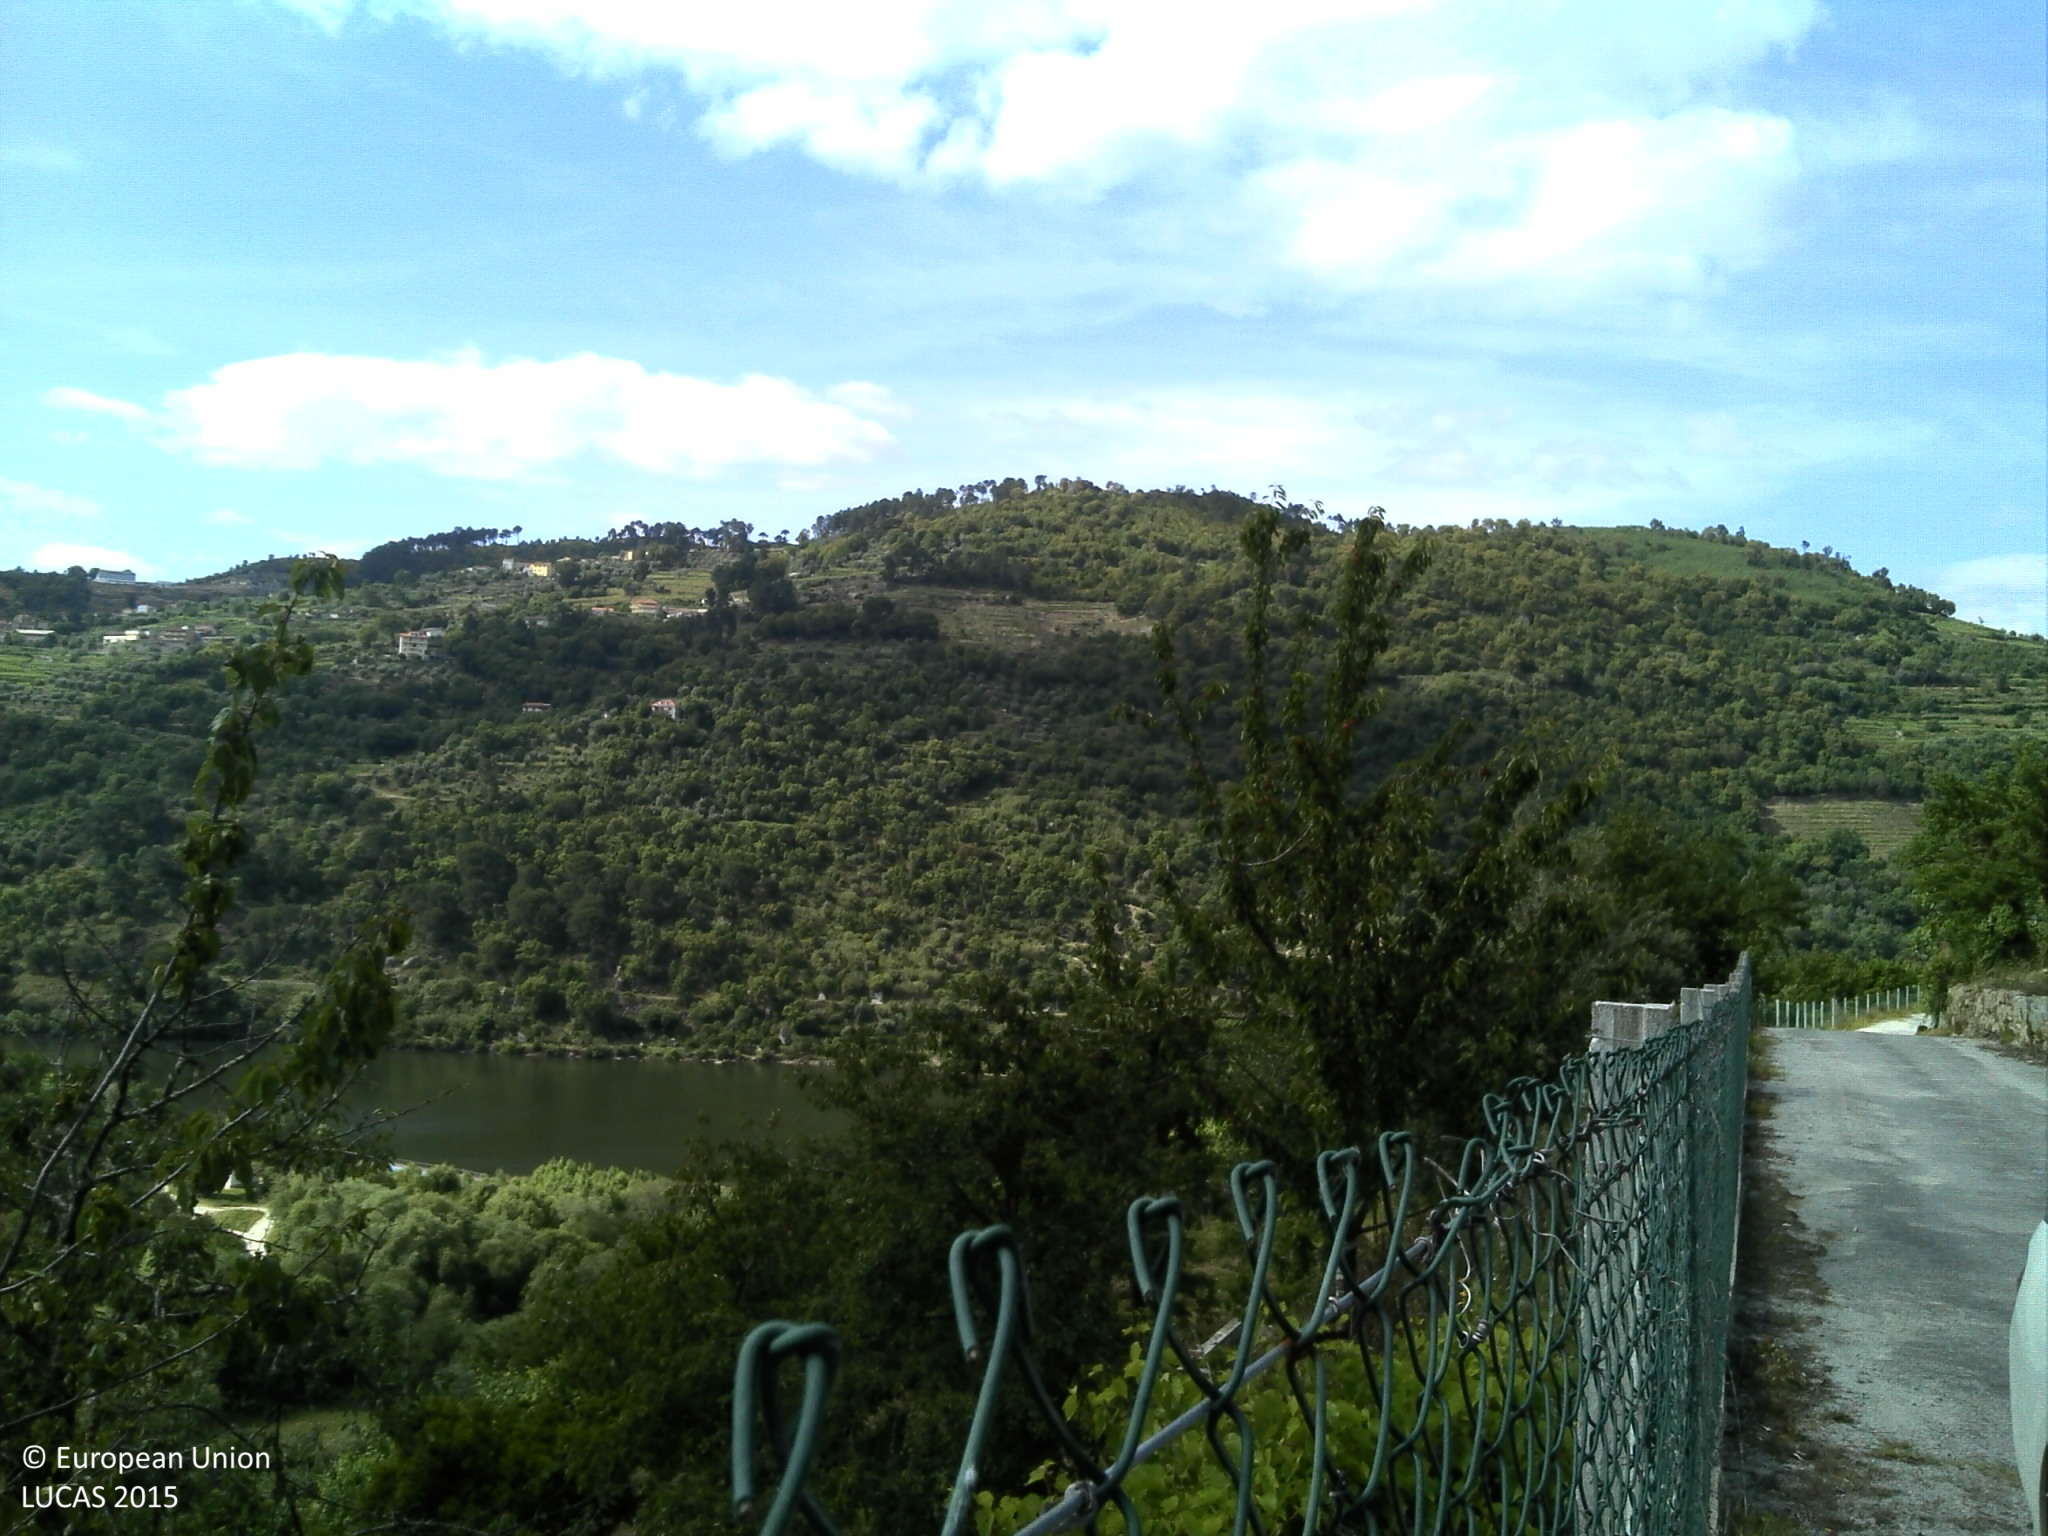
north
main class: Cropland
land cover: Cherry fruit
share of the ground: > 75 %
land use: Agriculture (excluding fallow land and kitchen gardens)
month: May
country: PT
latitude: 41.1155
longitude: -7.9127
